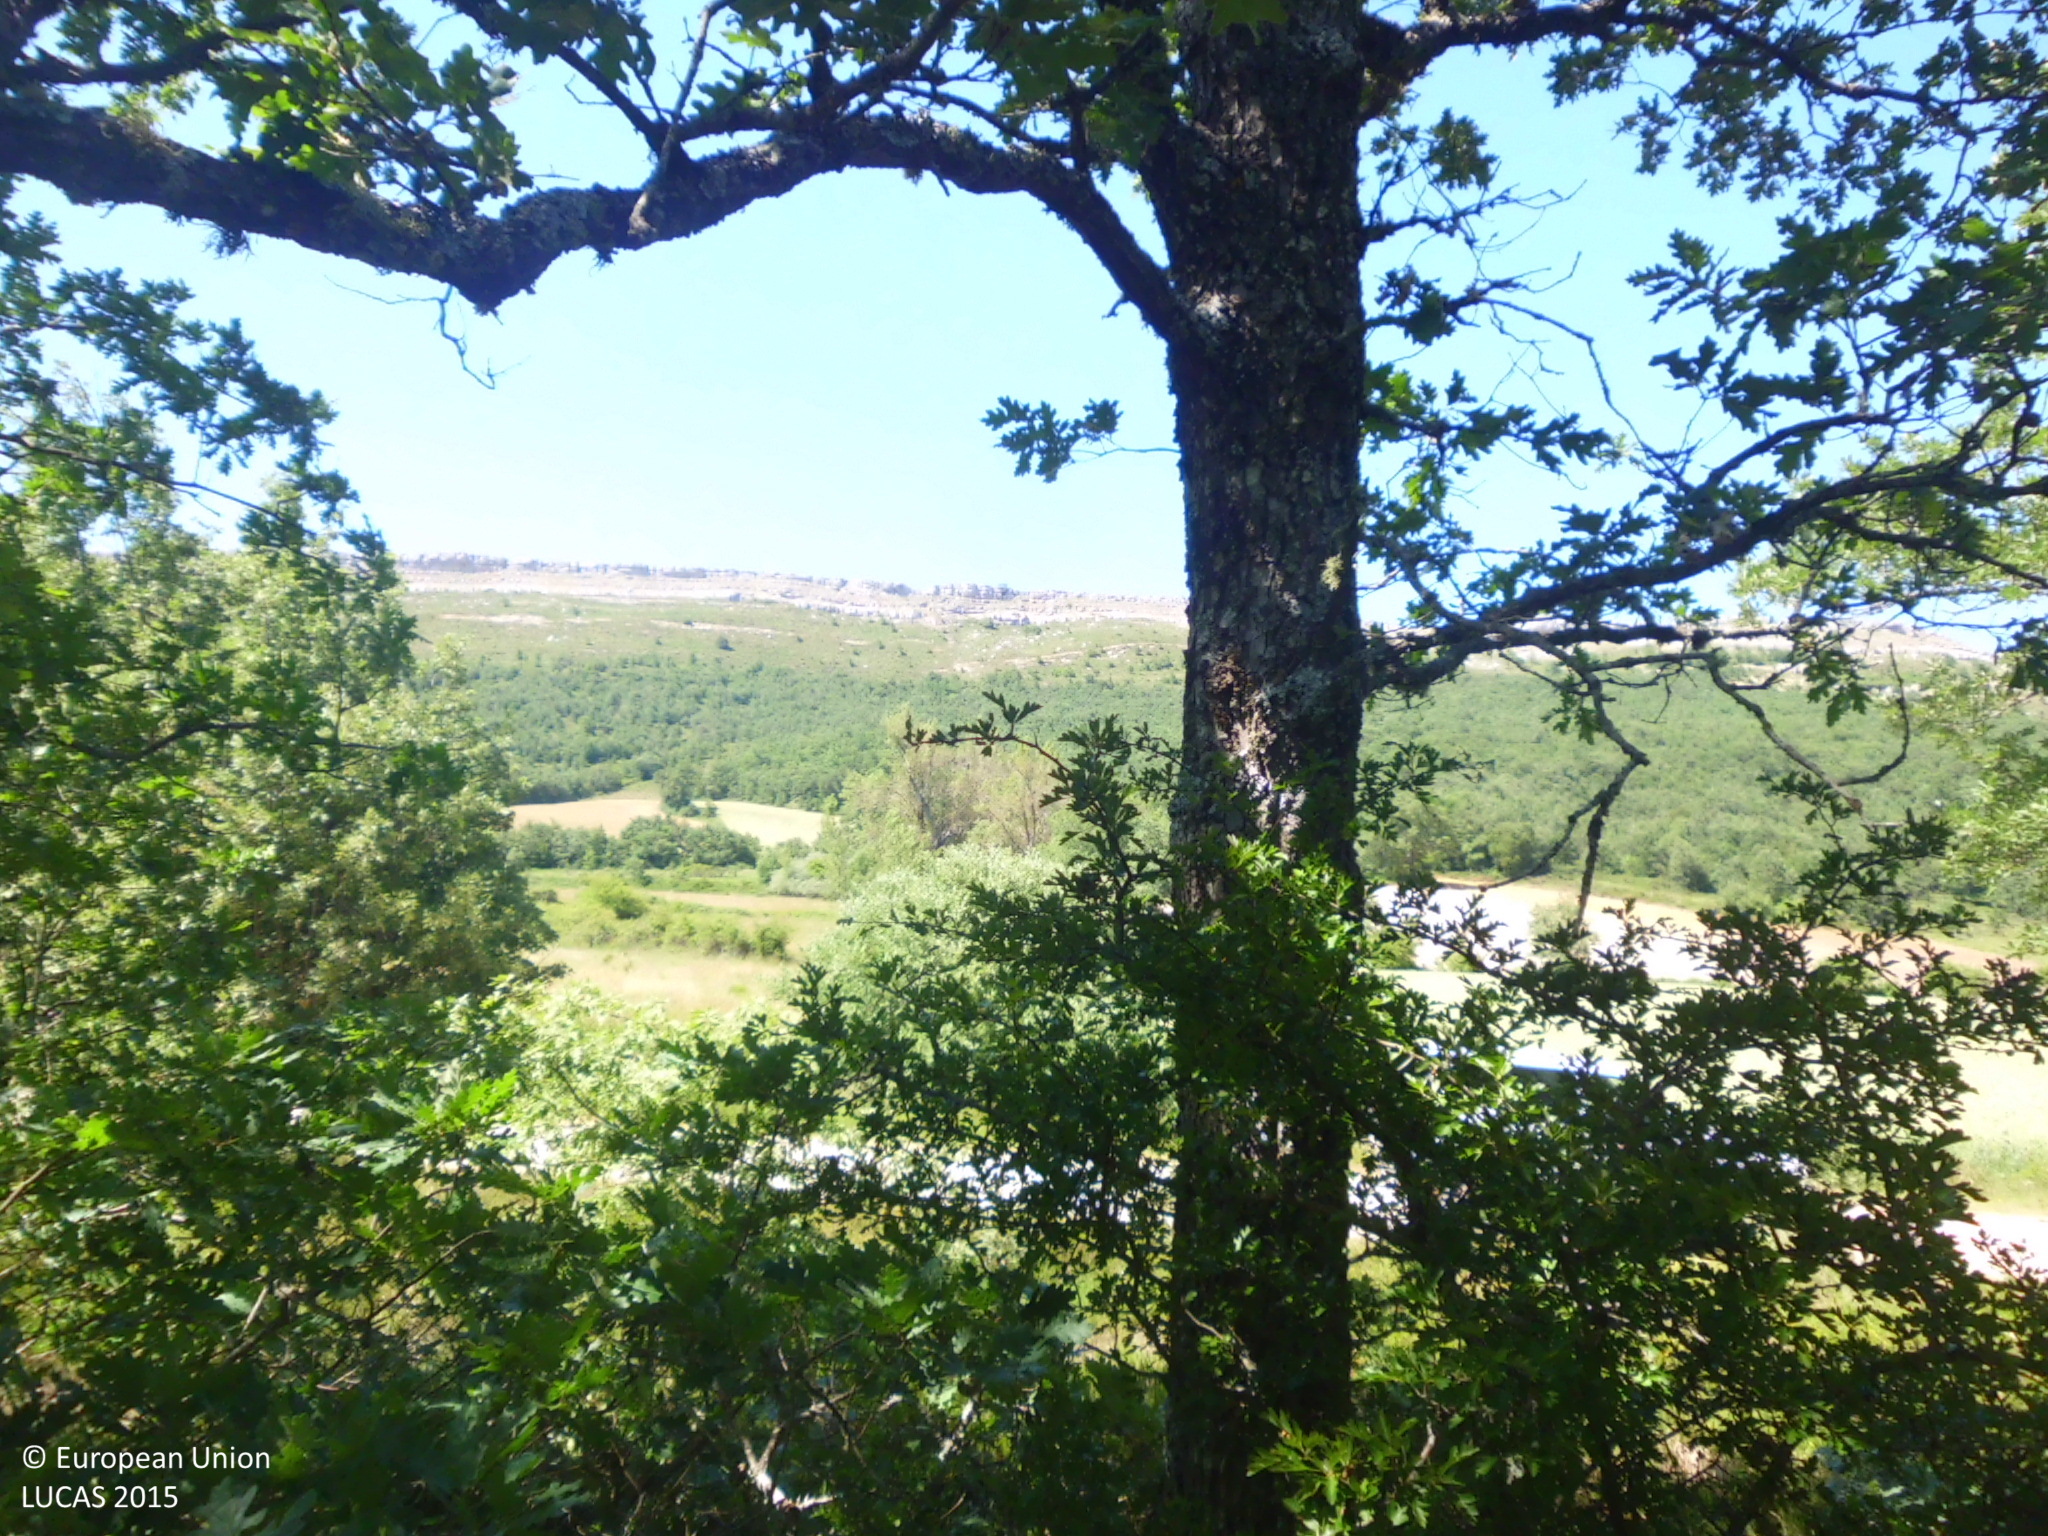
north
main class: Woodland
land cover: Broadleaved woodland
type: acidophilous oak and oak-birch forest
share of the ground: 25 - 50 %
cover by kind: broadleaved forest trees 40 %, shrubs 40 %, consolidated bare surface 15 %, herbaceous plants 5 %
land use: Semi-natural and natural areas not in use
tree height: > 5 m
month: June
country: ES
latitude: 42.6237
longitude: -4.0293
